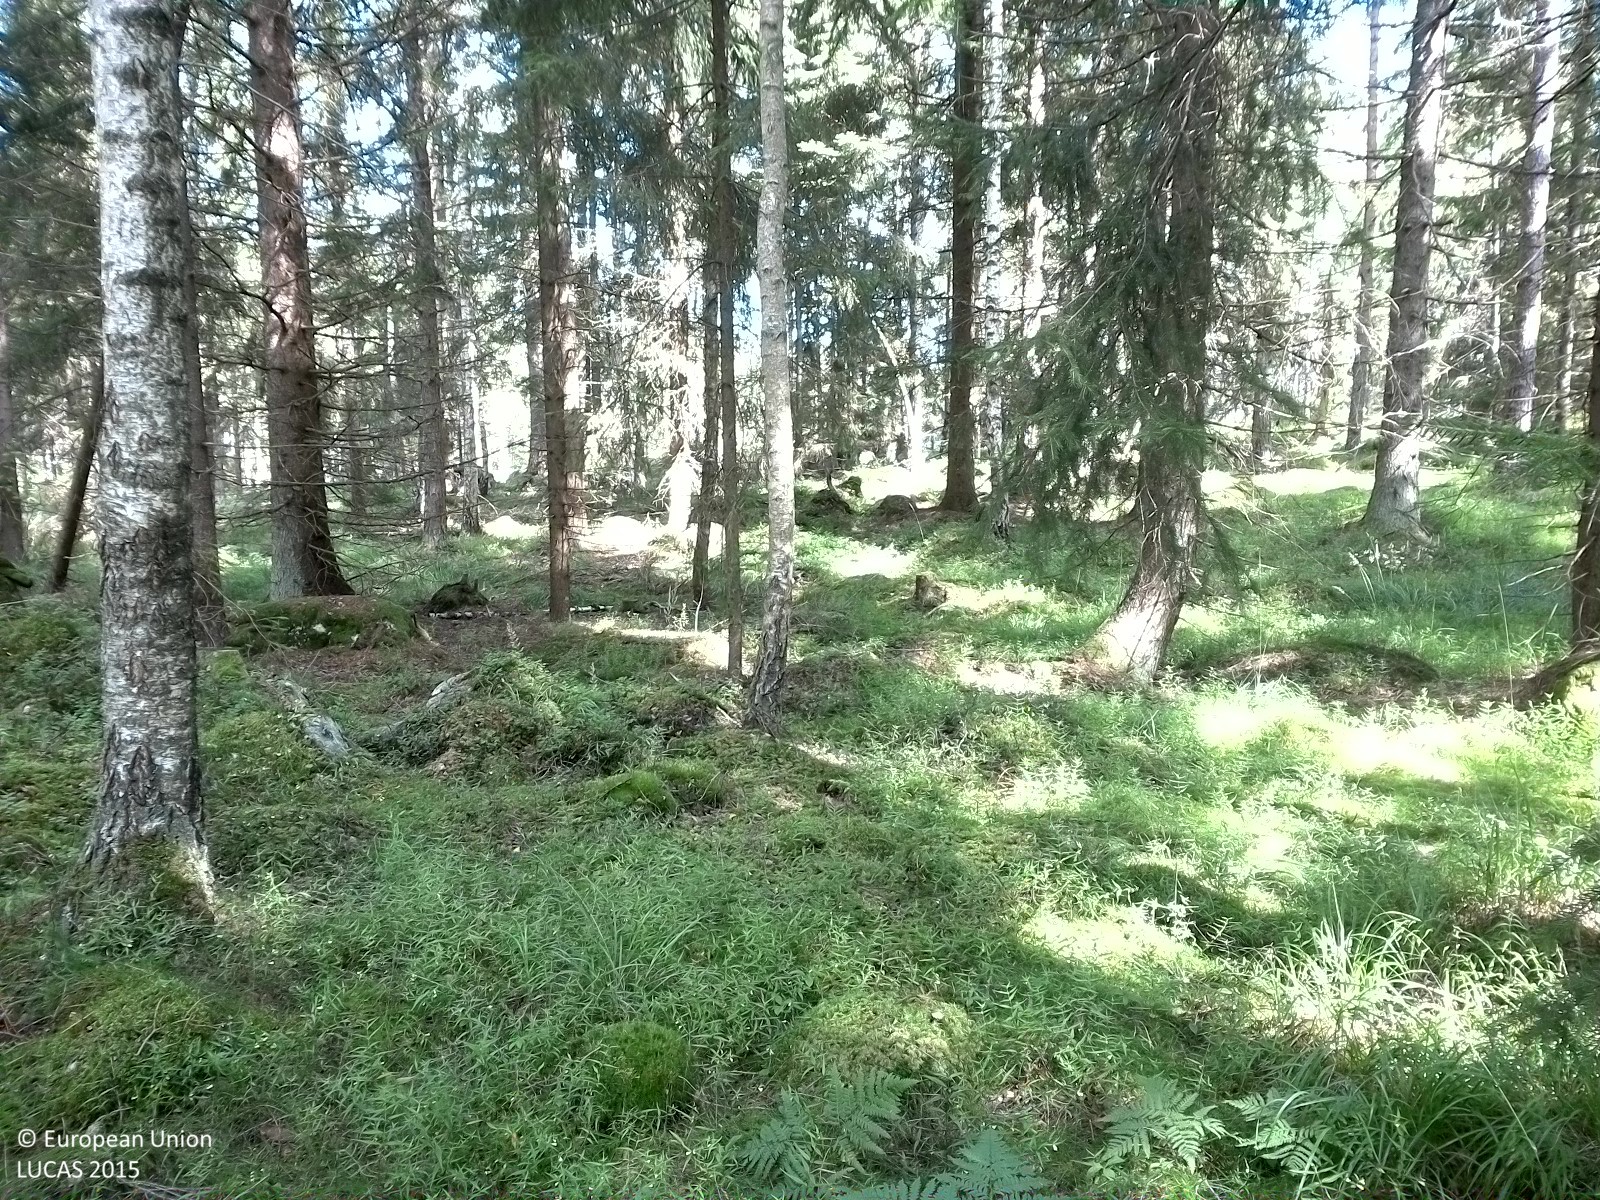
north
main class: Woodland
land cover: Spruce dominated mixed woodland
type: boreal forest
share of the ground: 25 - 50 %
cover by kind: herbaceous plants 35 %, coniferous forest trees 30 %, broadleaved forest trees 15 %, lichens and mosses 15 %, shrubs 5 %
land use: Forestry
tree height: > 5 m
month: August
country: SE
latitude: 59.0424
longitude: 15.0989
